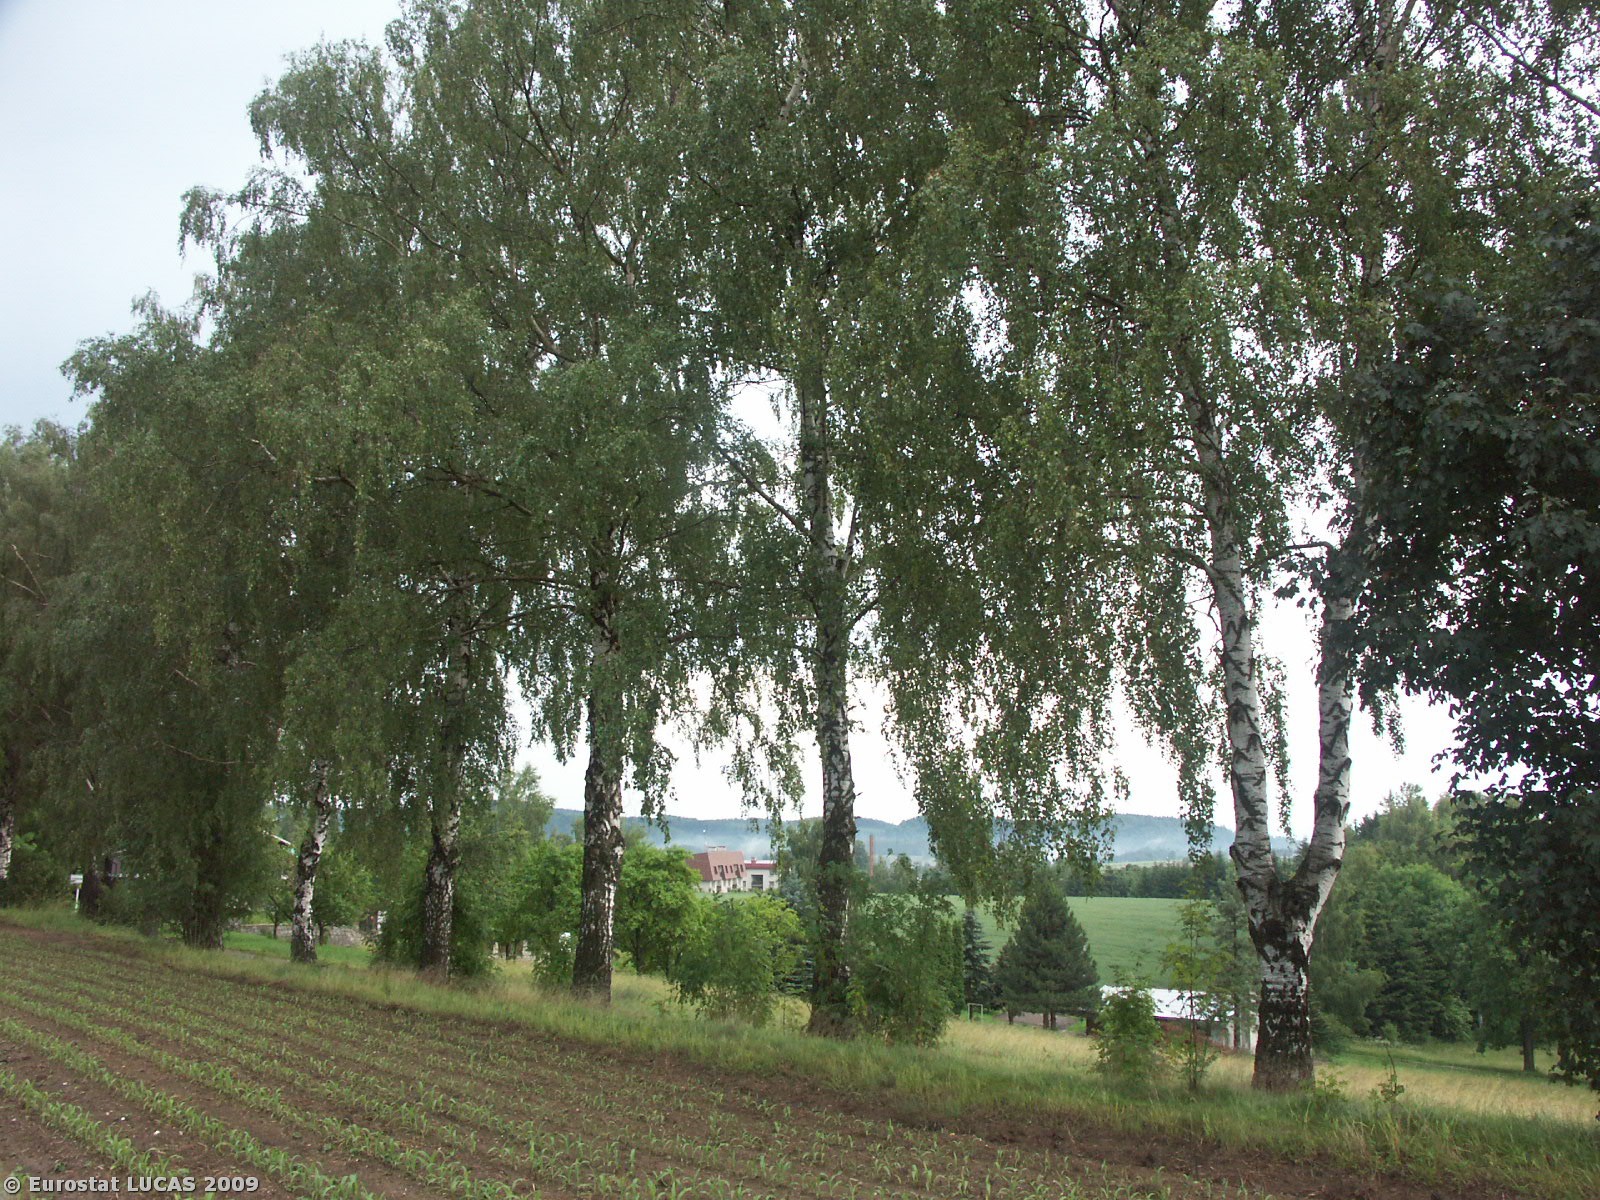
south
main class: Cropland
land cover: Maize
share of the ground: 10 - 25 %
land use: Agriculture (excluding fallow land and kitchen gardens)
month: July
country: CZ
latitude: 49.9894
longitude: 16.6614
